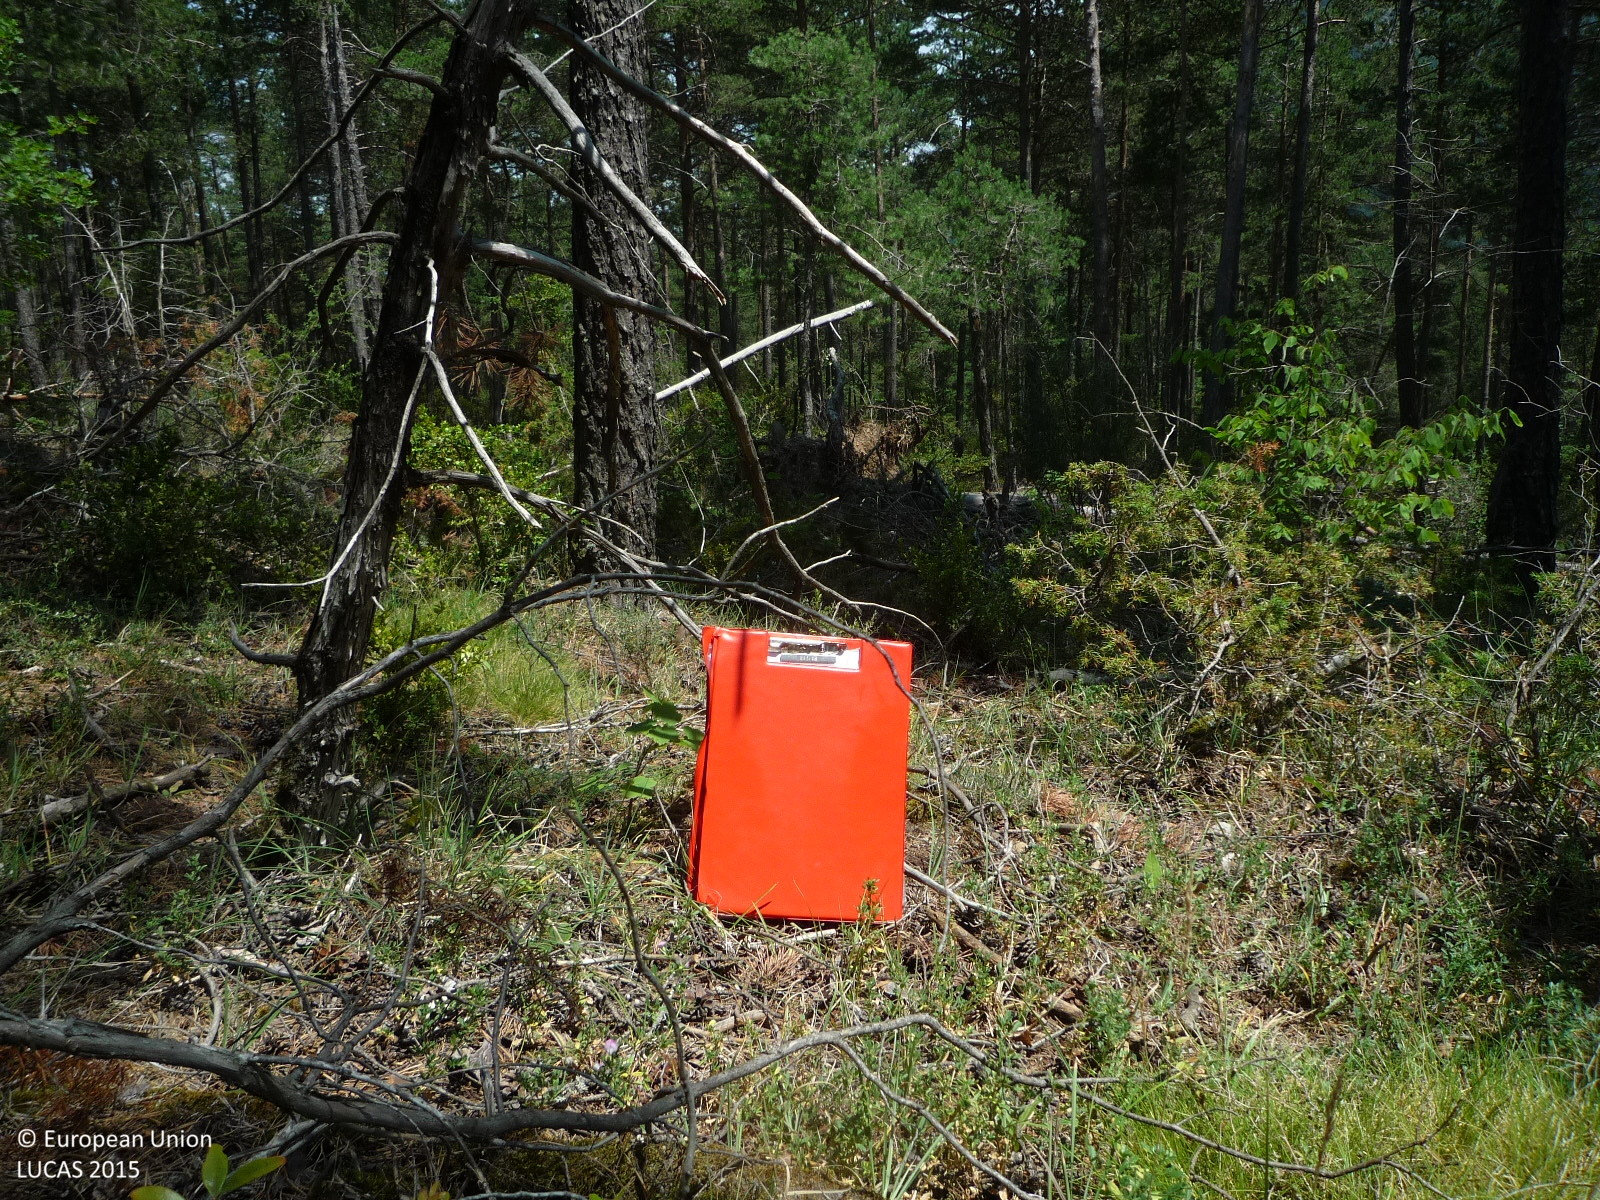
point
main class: Woodland
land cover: Pine dominated coniferous woodland
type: alpine coniferous forest
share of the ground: > 75 %
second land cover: Grassland without tree/shrub cover
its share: > 75 %
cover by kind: coniferous forest trees 80 %, herbaceous plants 20 %
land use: Forestry
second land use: Agriculture (excluding fallow land and kitchen gardens)
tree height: > 5 m
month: July
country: ES
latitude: 42.2033
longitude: 1.6912
